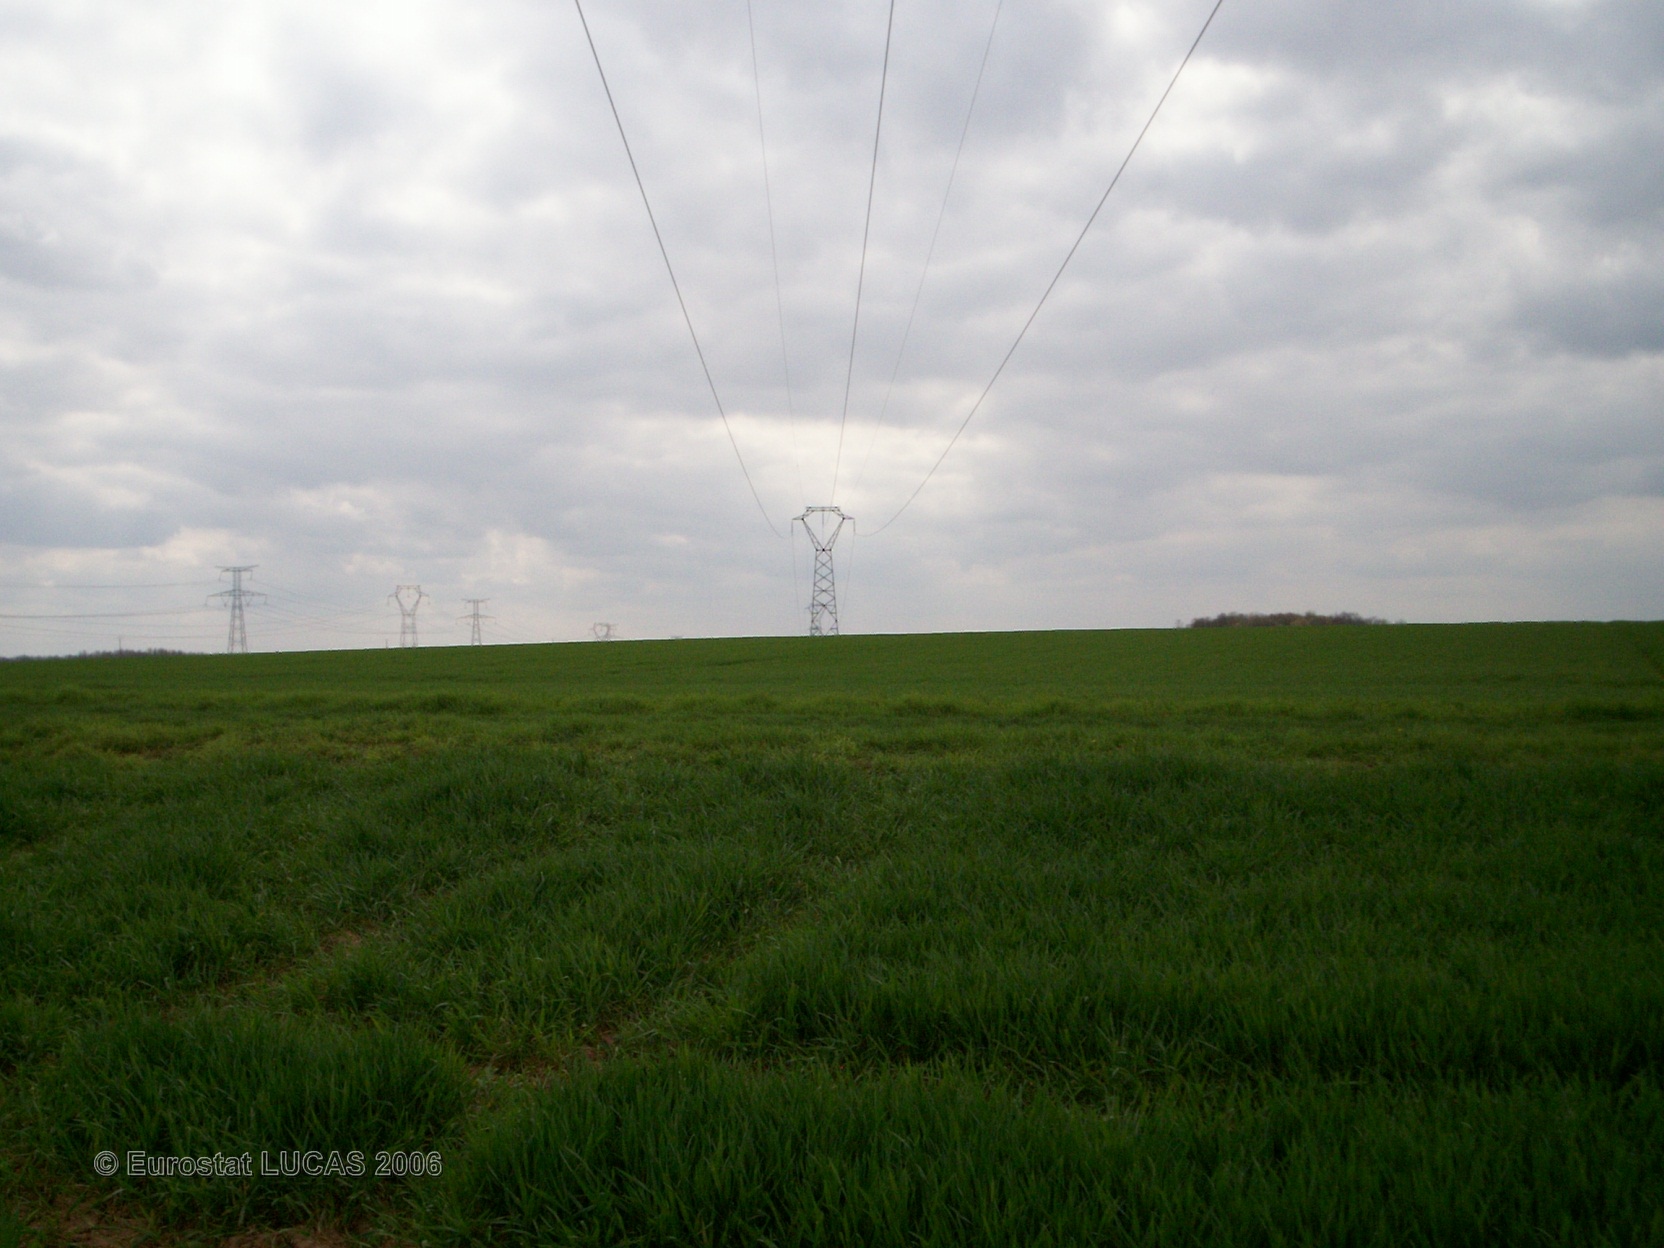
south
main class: Cropland
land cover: Common wheat
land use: Agriculture (excluding fallow land and kitchen gardens)
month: April
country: FR
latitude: 48.2436
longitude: 2.8412
